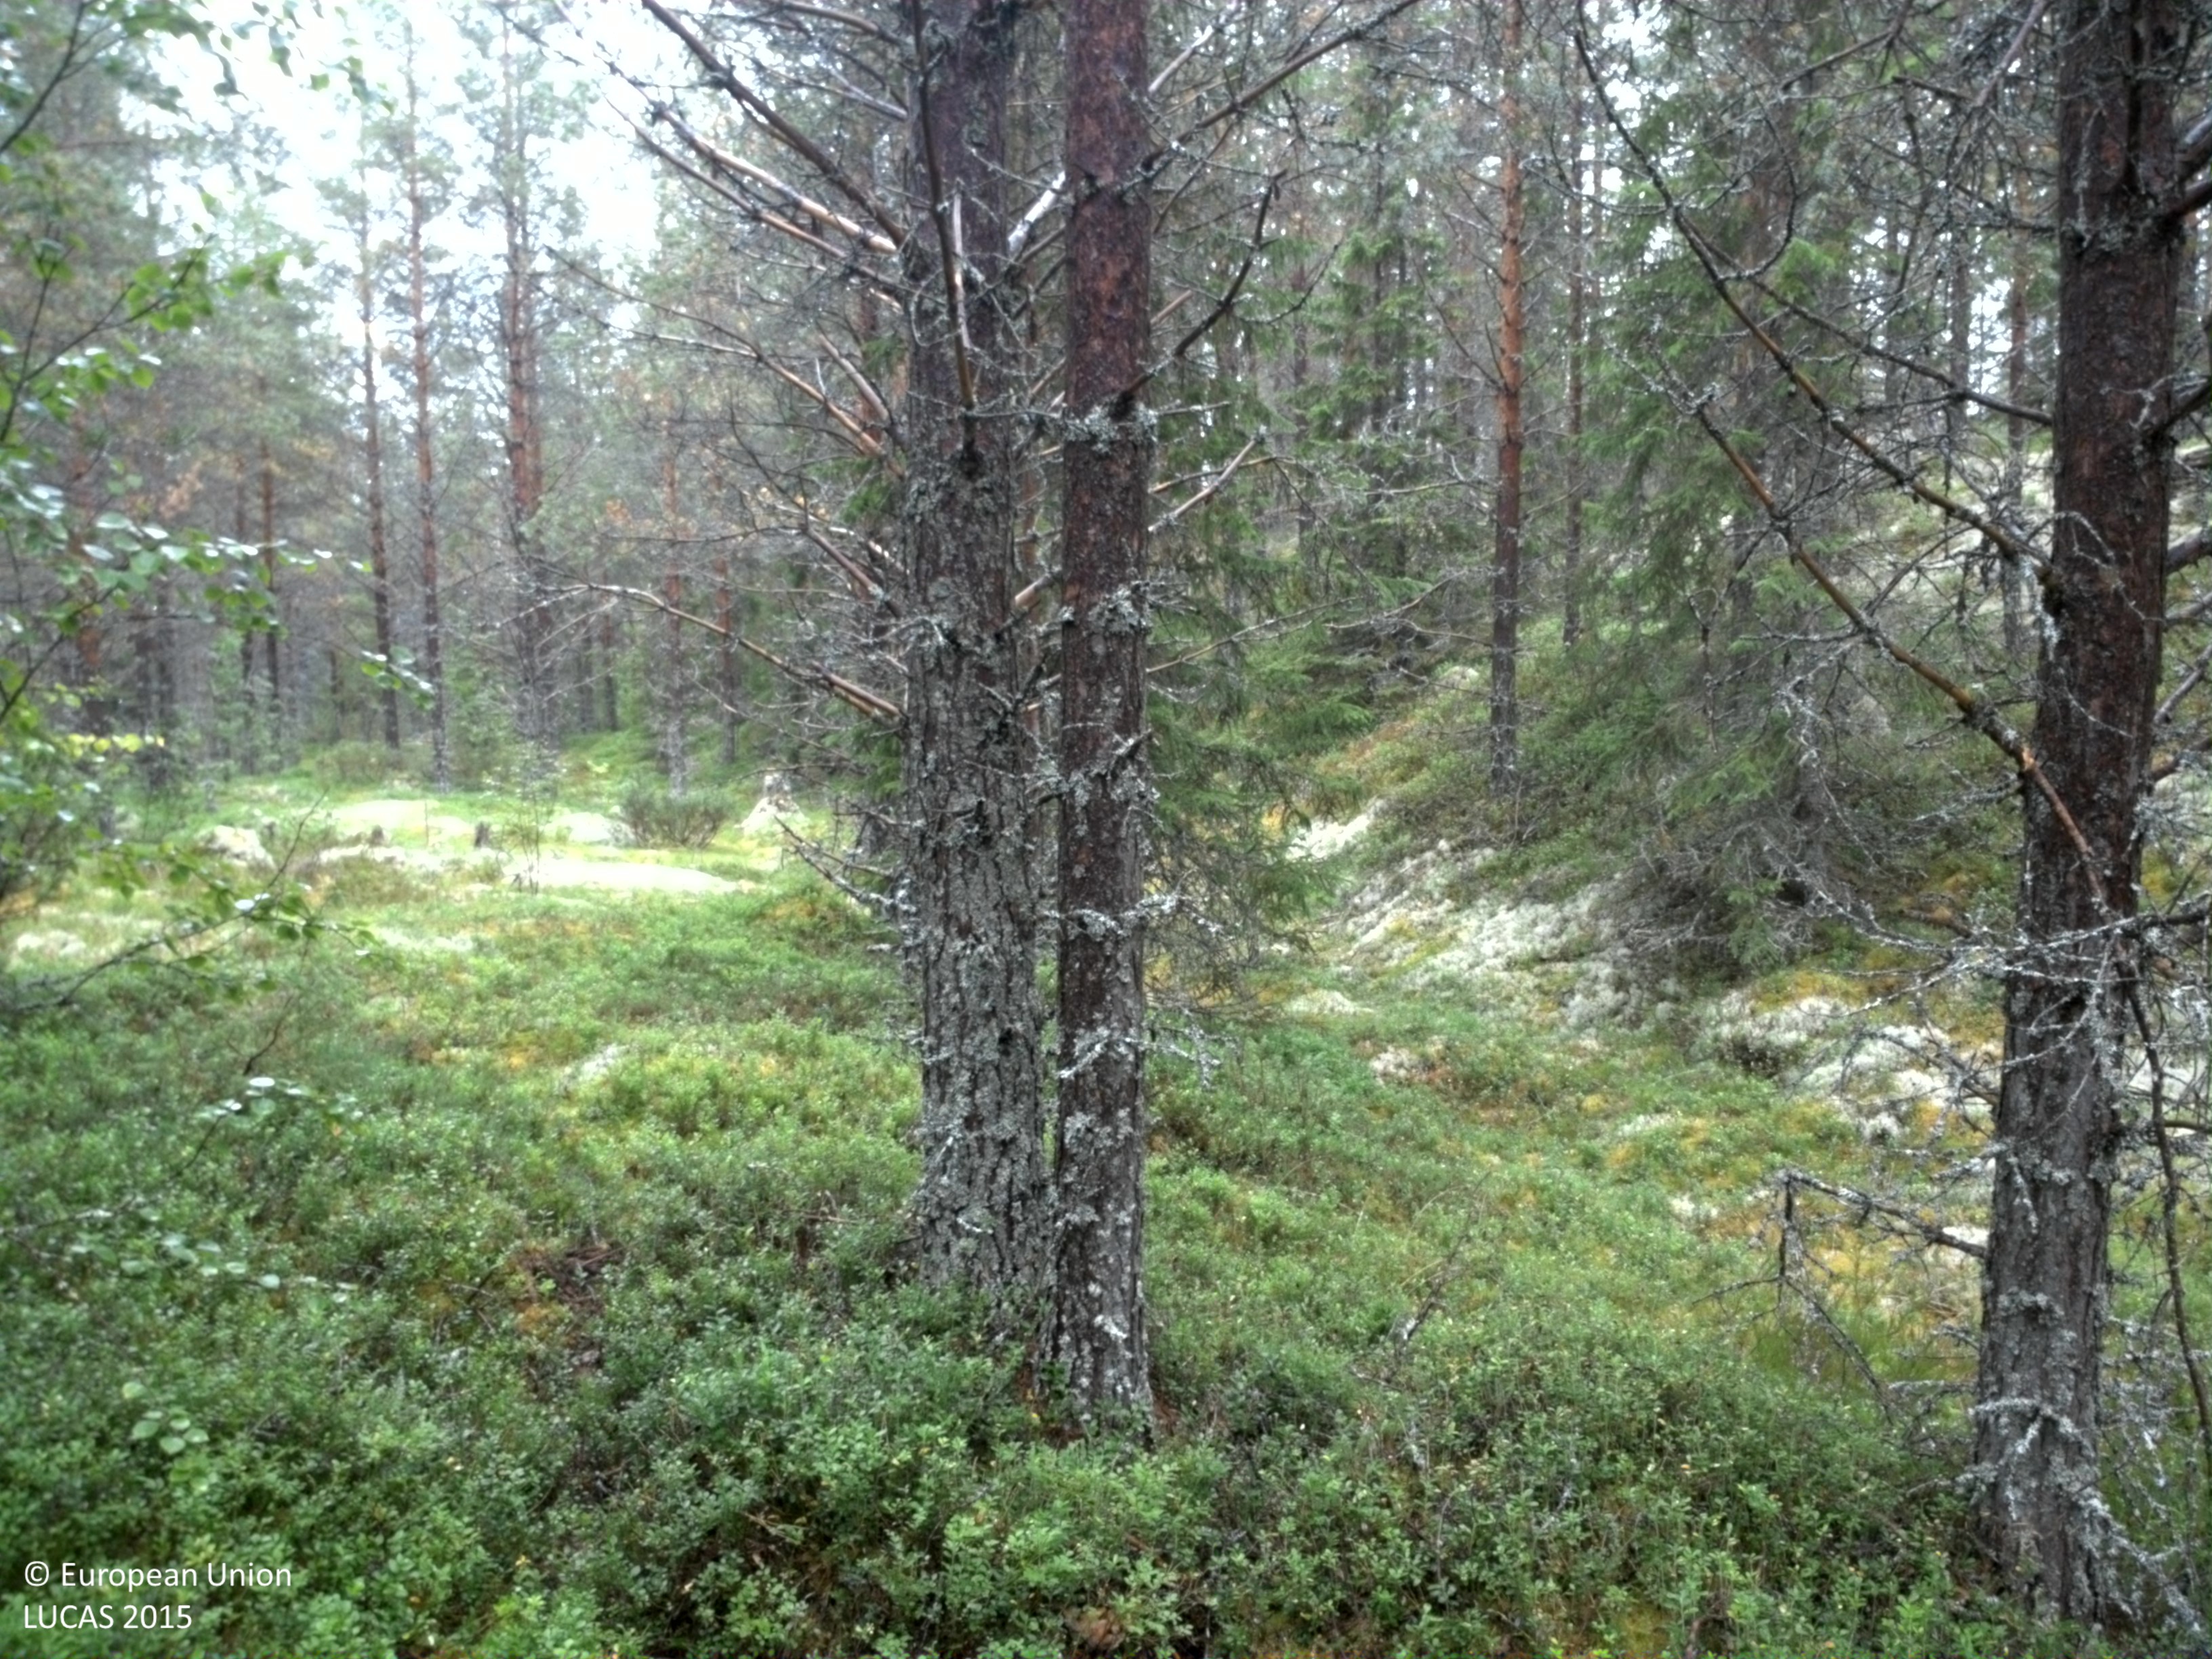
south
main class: Woodland
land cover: Pine dominated coniferous woodland
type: boreal forest
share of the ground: 50 - 75 %
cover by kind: coniferous forest trees 50 %, shrubs 25 %, lichens and mosses 15 %, broadleaved forest trees 10 %
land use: Forestry
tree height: > 5 m
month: August
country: SE
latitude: 61.7884
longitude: 15.0084
